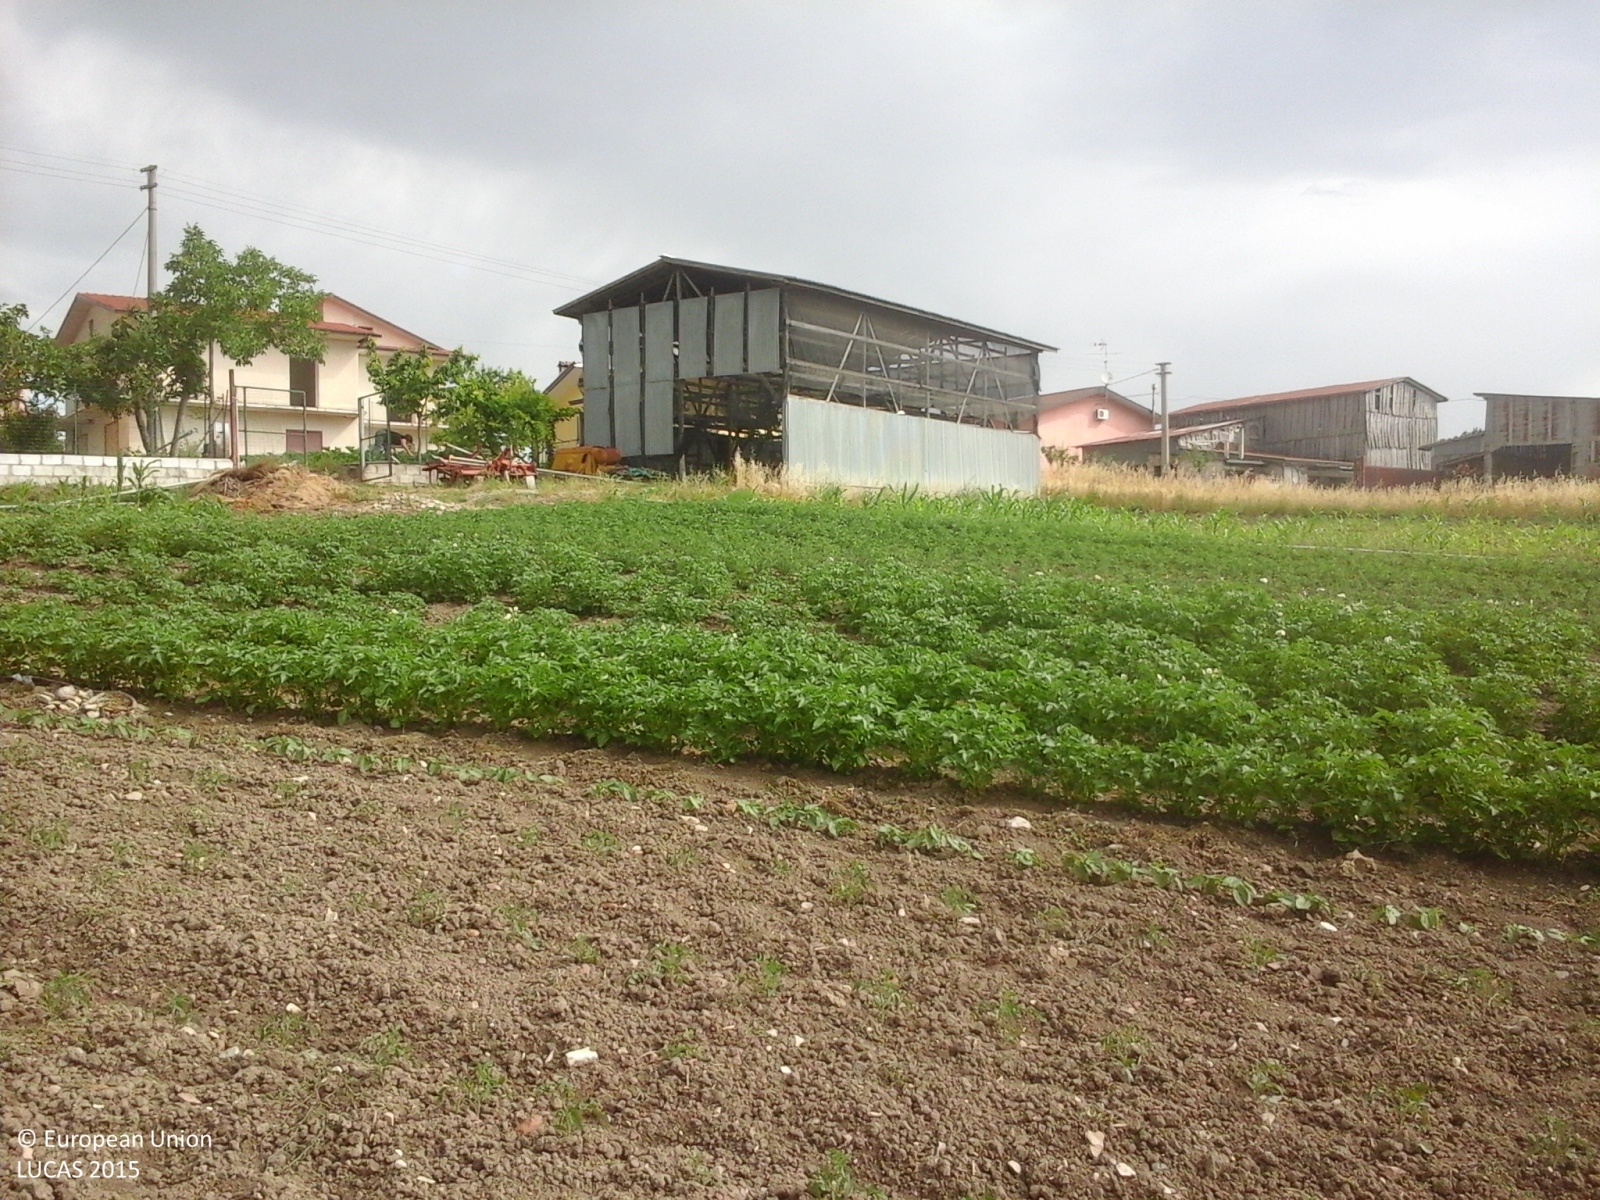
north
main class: Cropland
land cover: Maize
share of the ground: 25 - 50 %
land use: Agriculture (excluding fallow land and kitchen gardens)
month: June
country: IT
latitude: 41.0381
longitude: 15.1552
